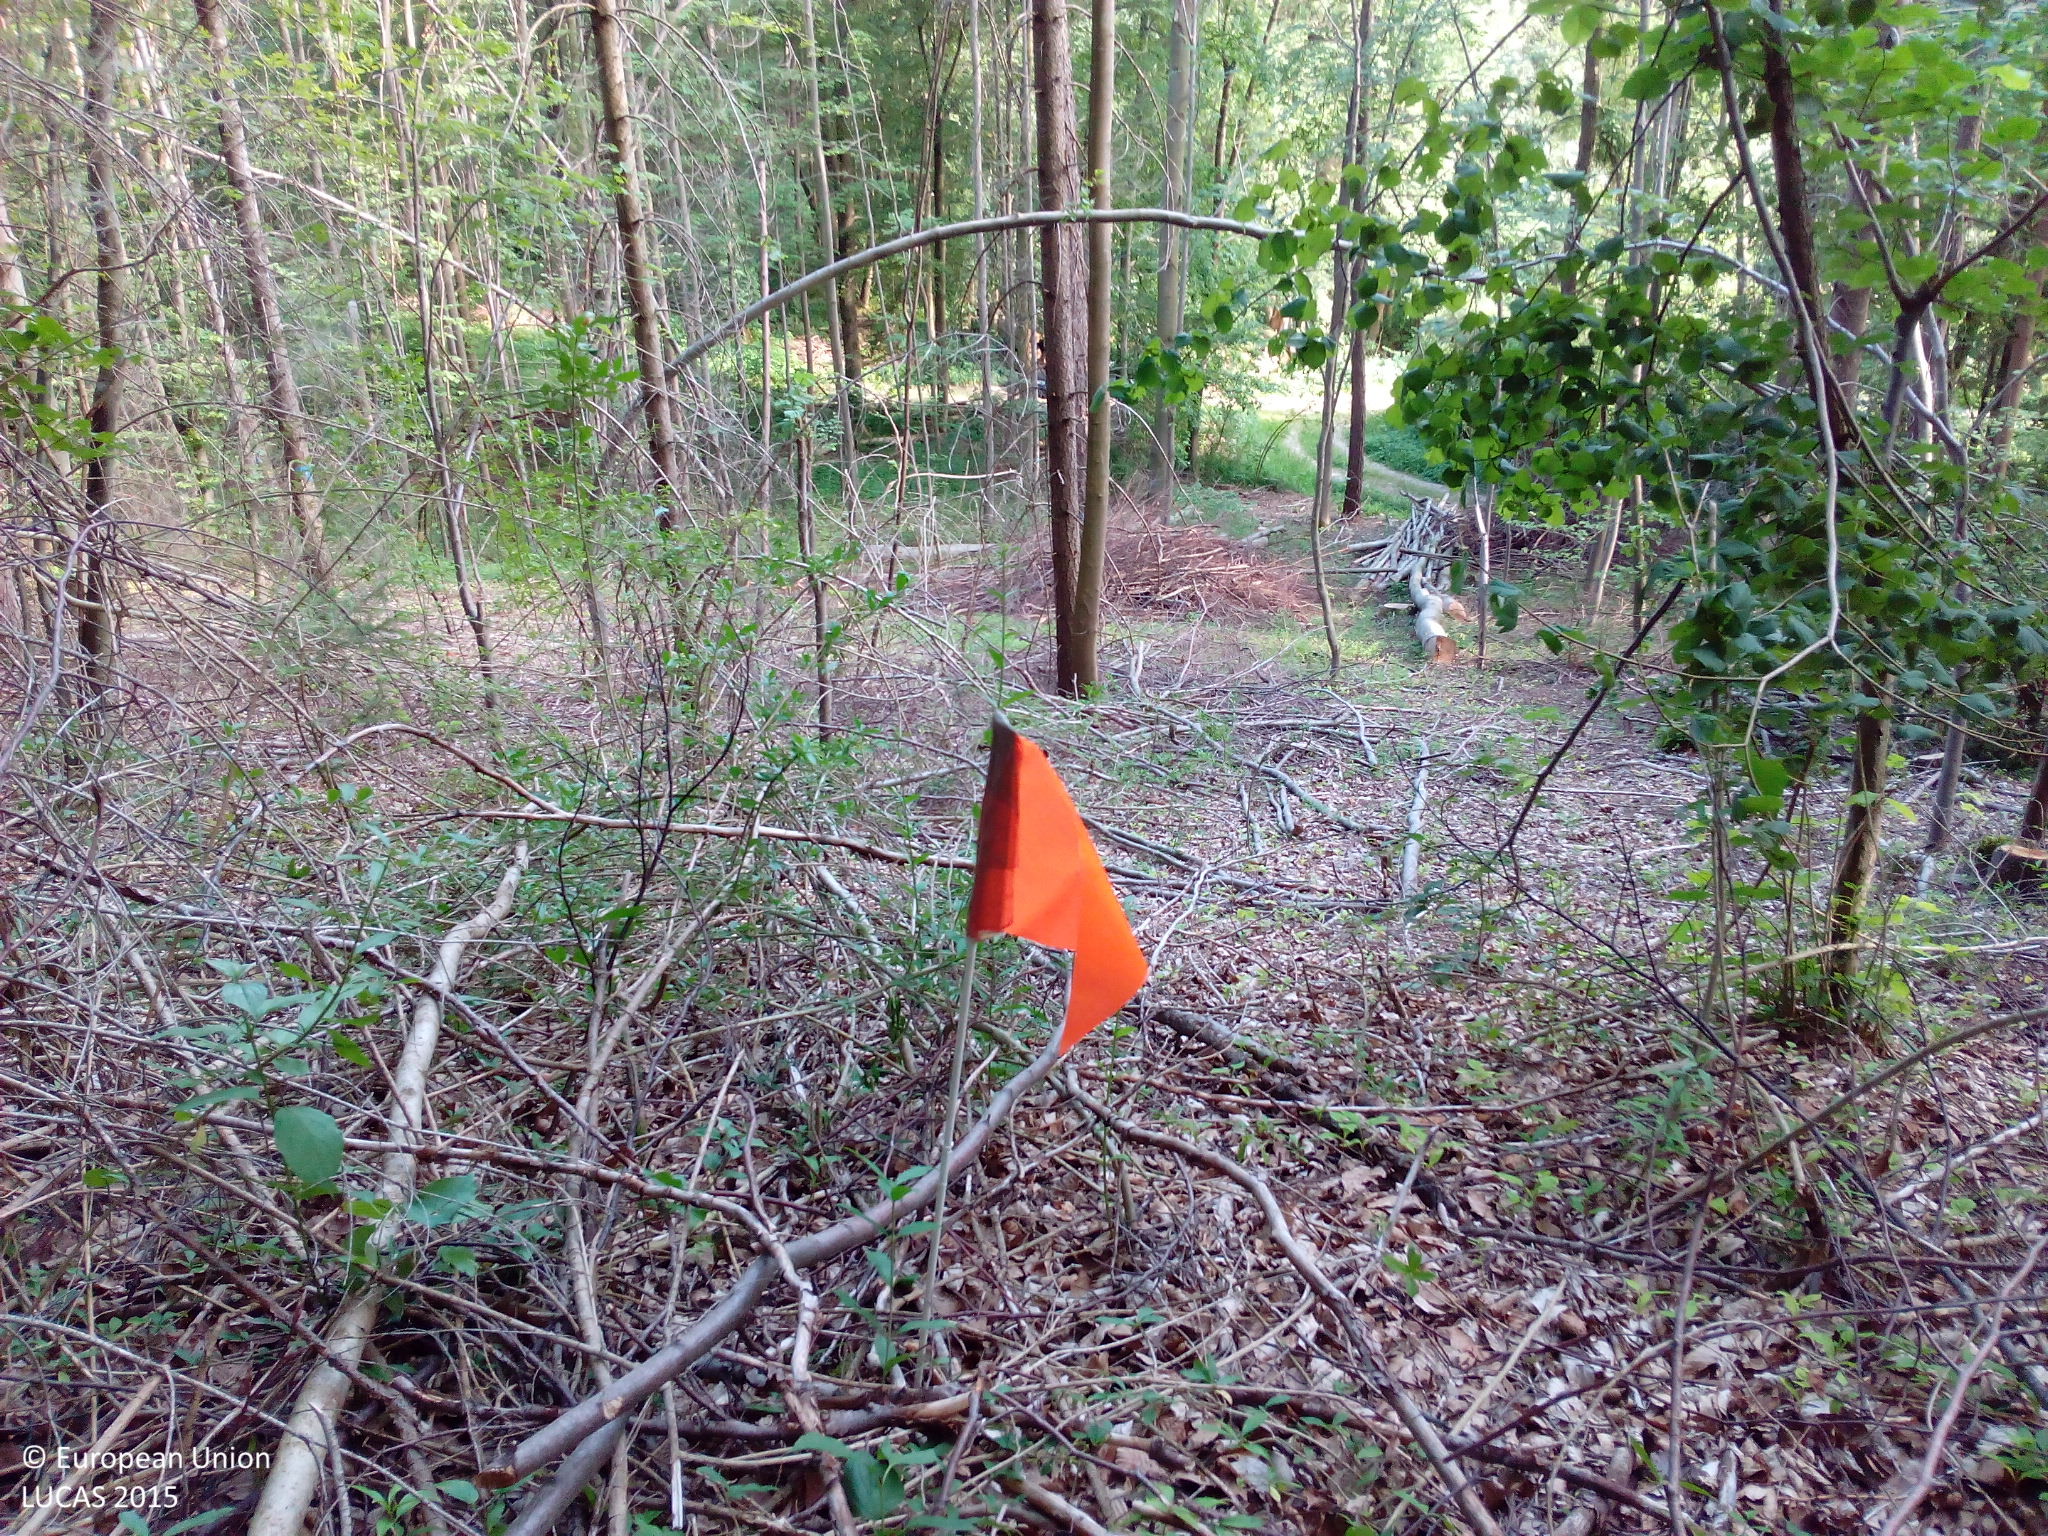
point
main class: Woodland
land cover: Spruce dominated mixed woodland
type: hemiboreal forest and nemoral coniferous forest and mixed broadleaved-coniferous forest
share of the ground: > 75 %
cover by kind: broadleaved forest trees 65 %, coniferous forest trees 25 %, unconsolidated bare surface 10 %
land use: Forestry
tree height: > 5 m
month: July
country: DE
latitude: 48.6010
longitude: 9.6883
